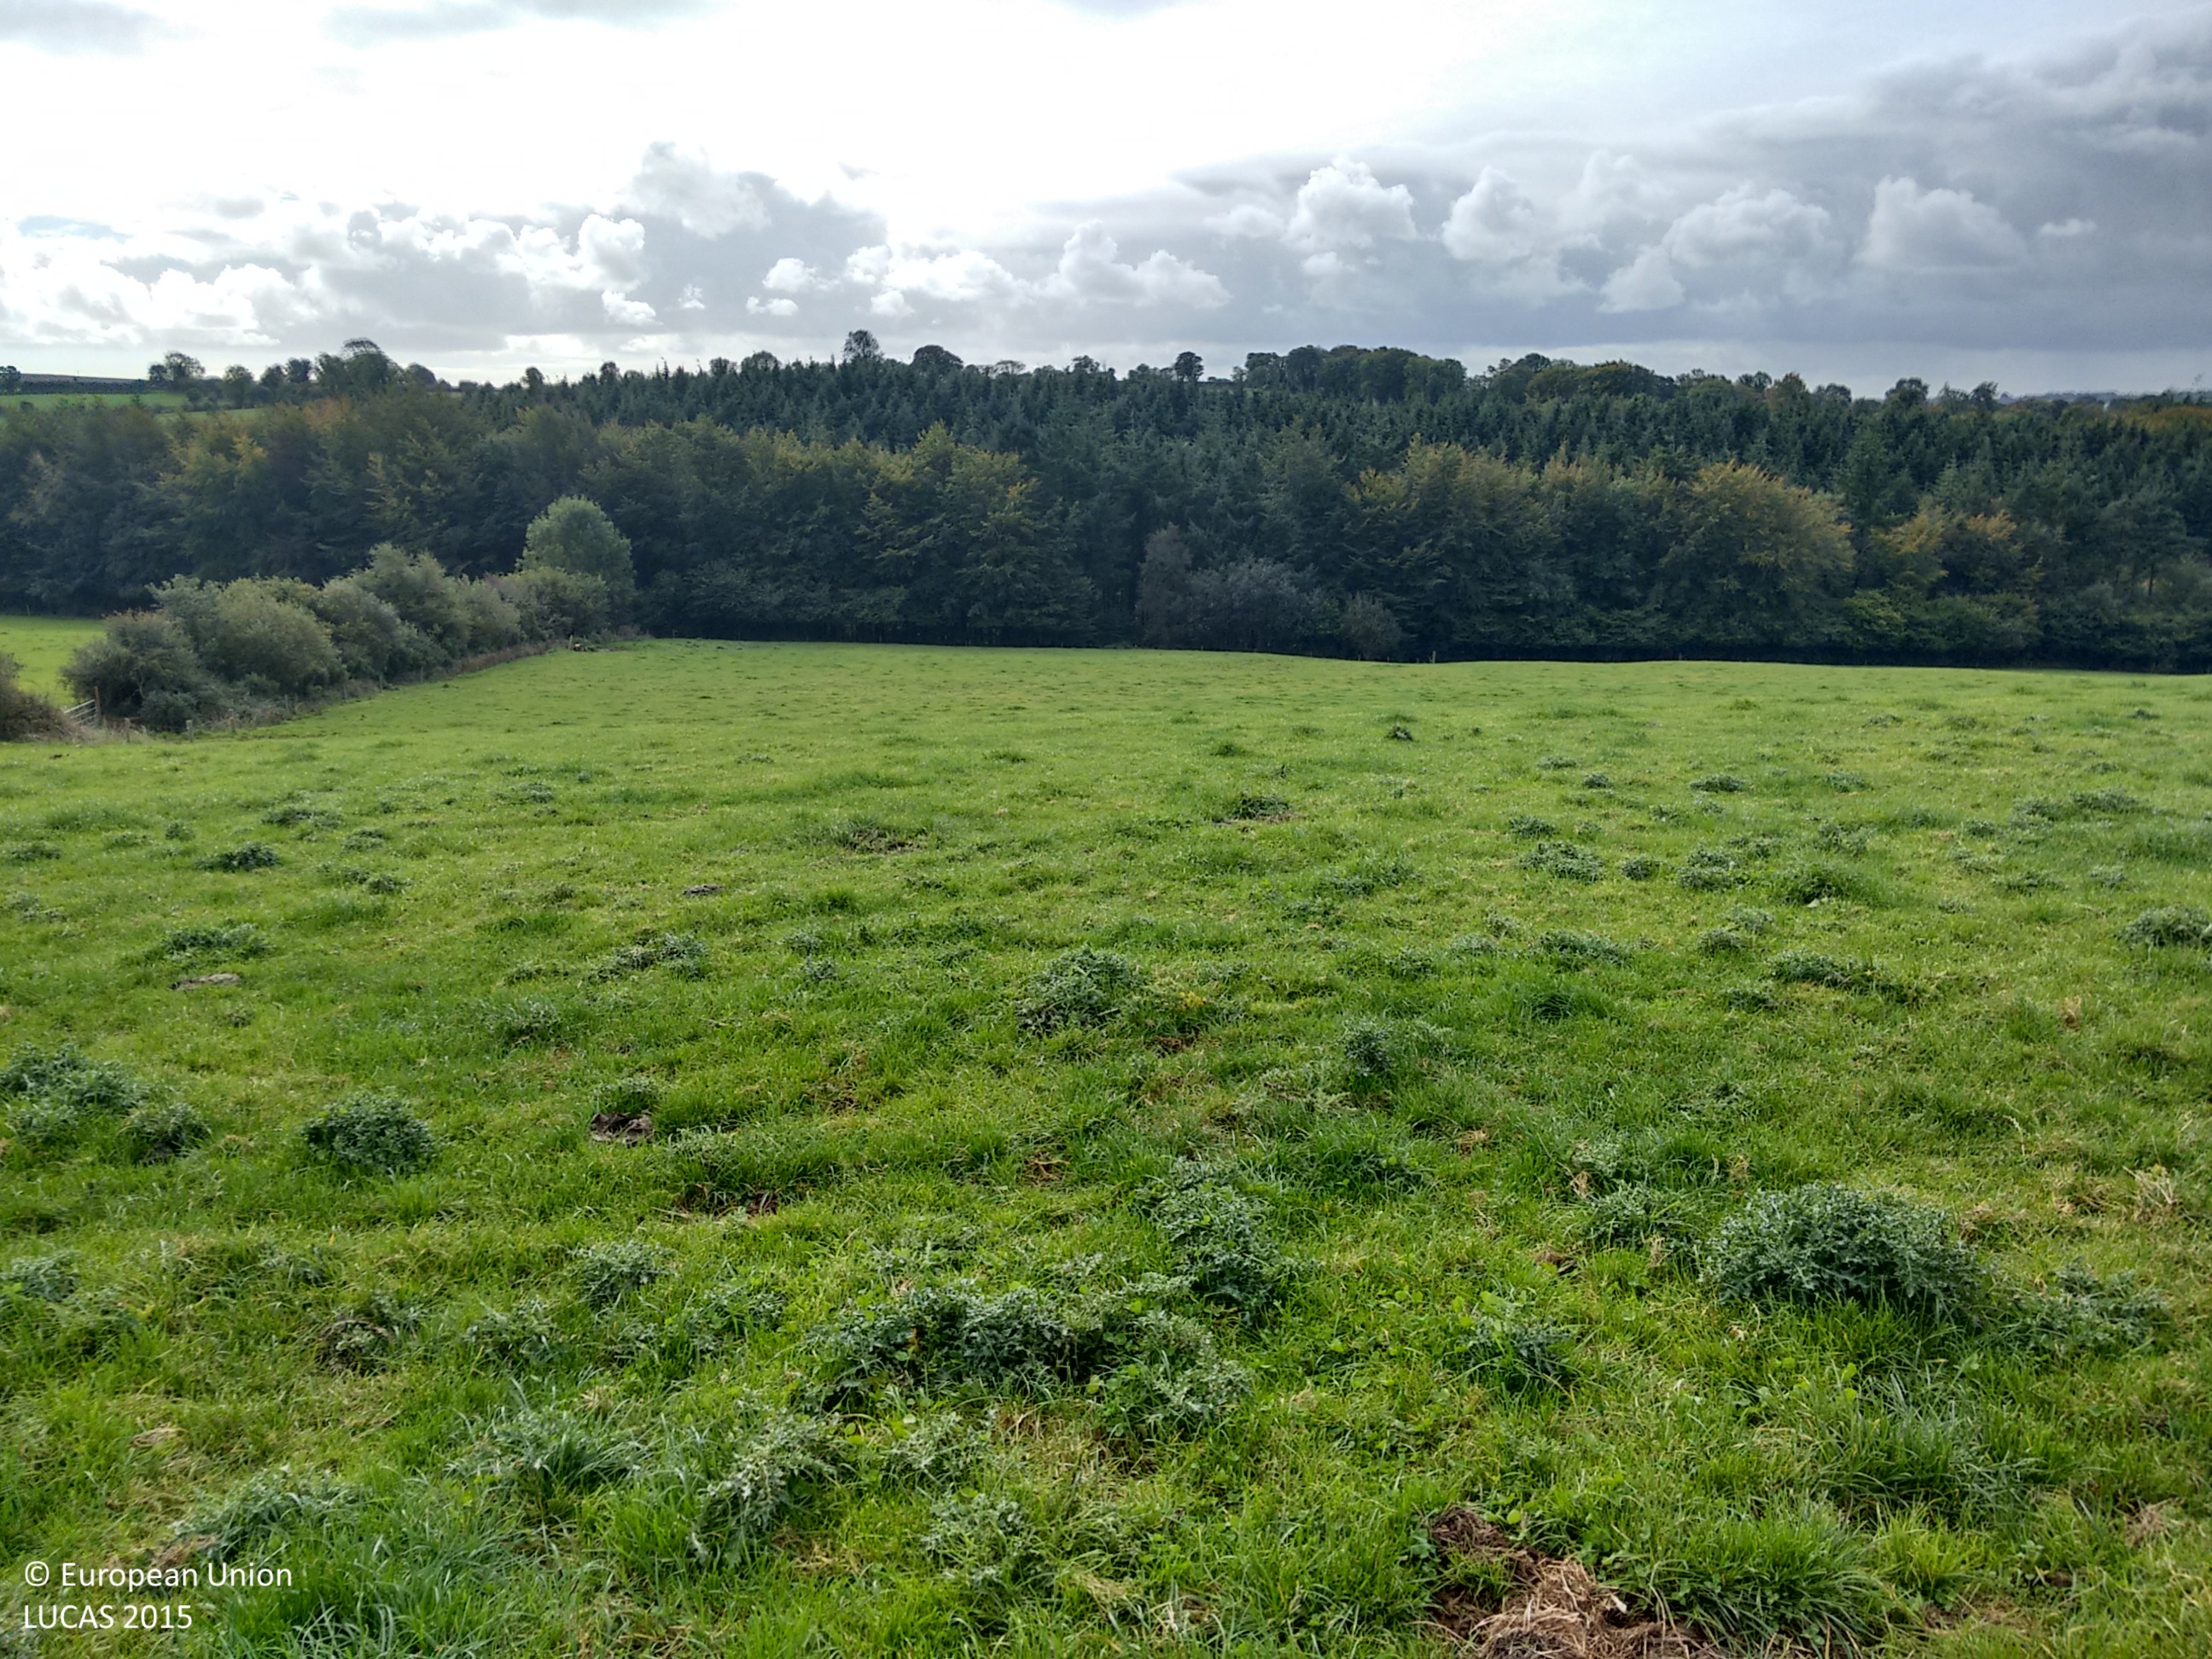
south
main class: Grassland
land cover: Grassland without tree/shrub cover
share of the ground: > 75 %
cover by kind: herbaceous plants 100 %
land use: Agriculture (excluding fallow land and kitchen gardens)
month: October
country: IE
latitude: 51.9602
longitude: -8.3657
